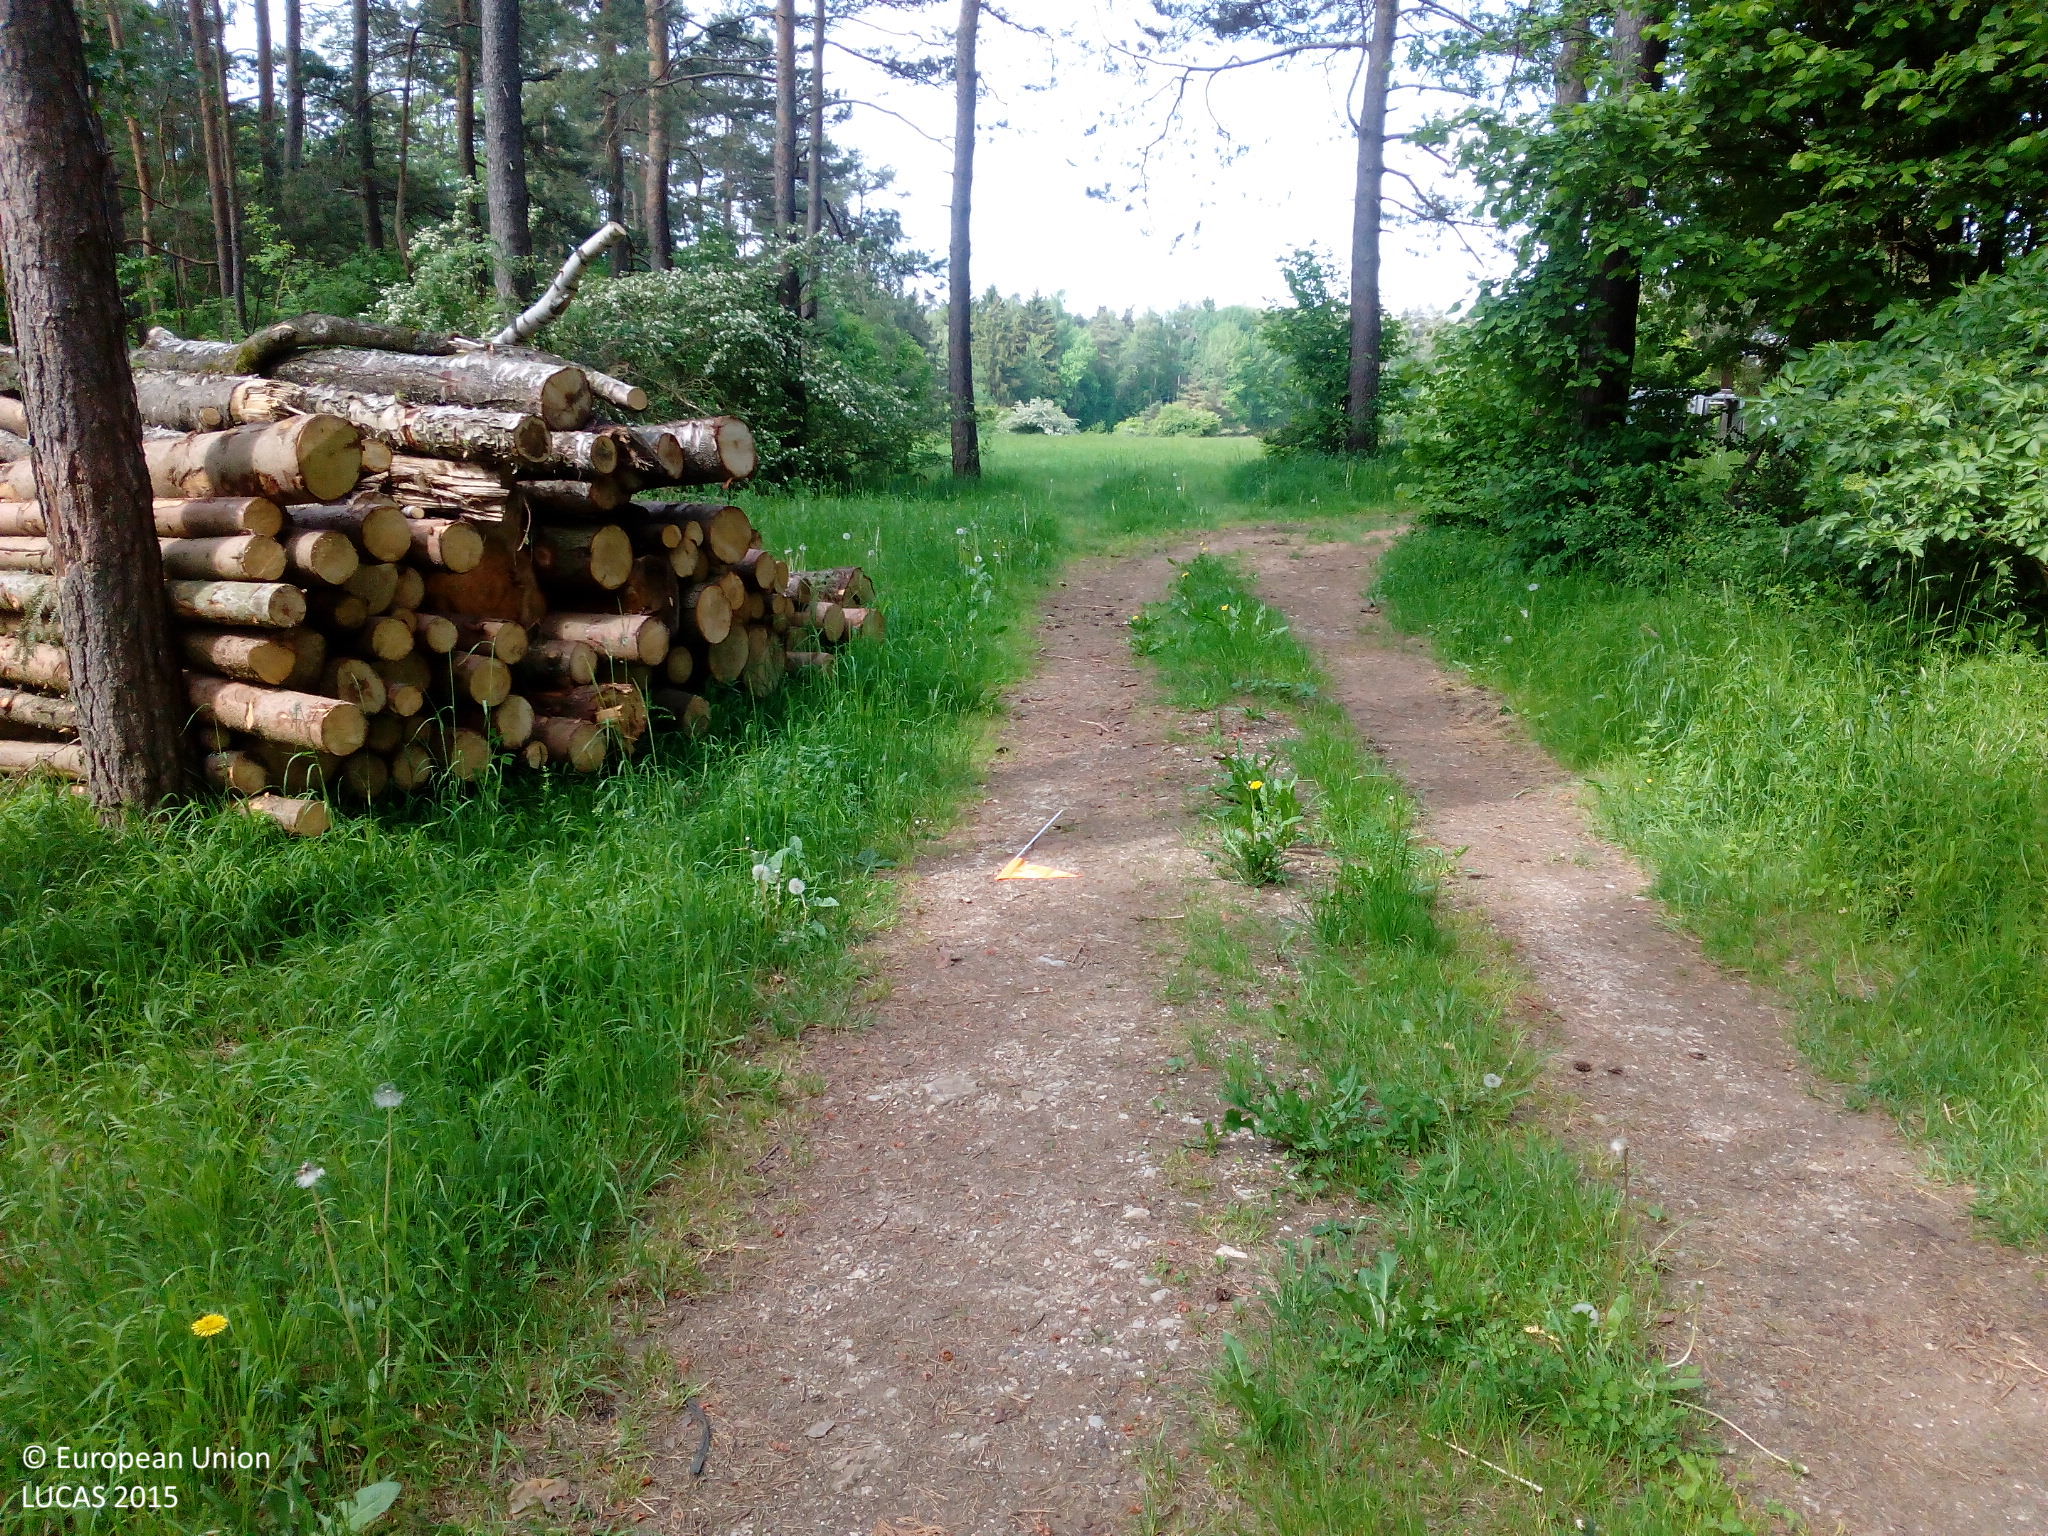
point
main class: Woodland
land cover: Other mixed woodland
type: hemiboreal forest and nemoral coniferous forest and mixed broadleaved-coniferous forest
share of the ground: > 75 %
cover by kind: coniferous forest trees 50 %, broadleaved forest trees 50 %
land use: Forestry
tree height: > 5 m
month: May
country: DE
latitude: 49.7968
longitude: 11.4861
